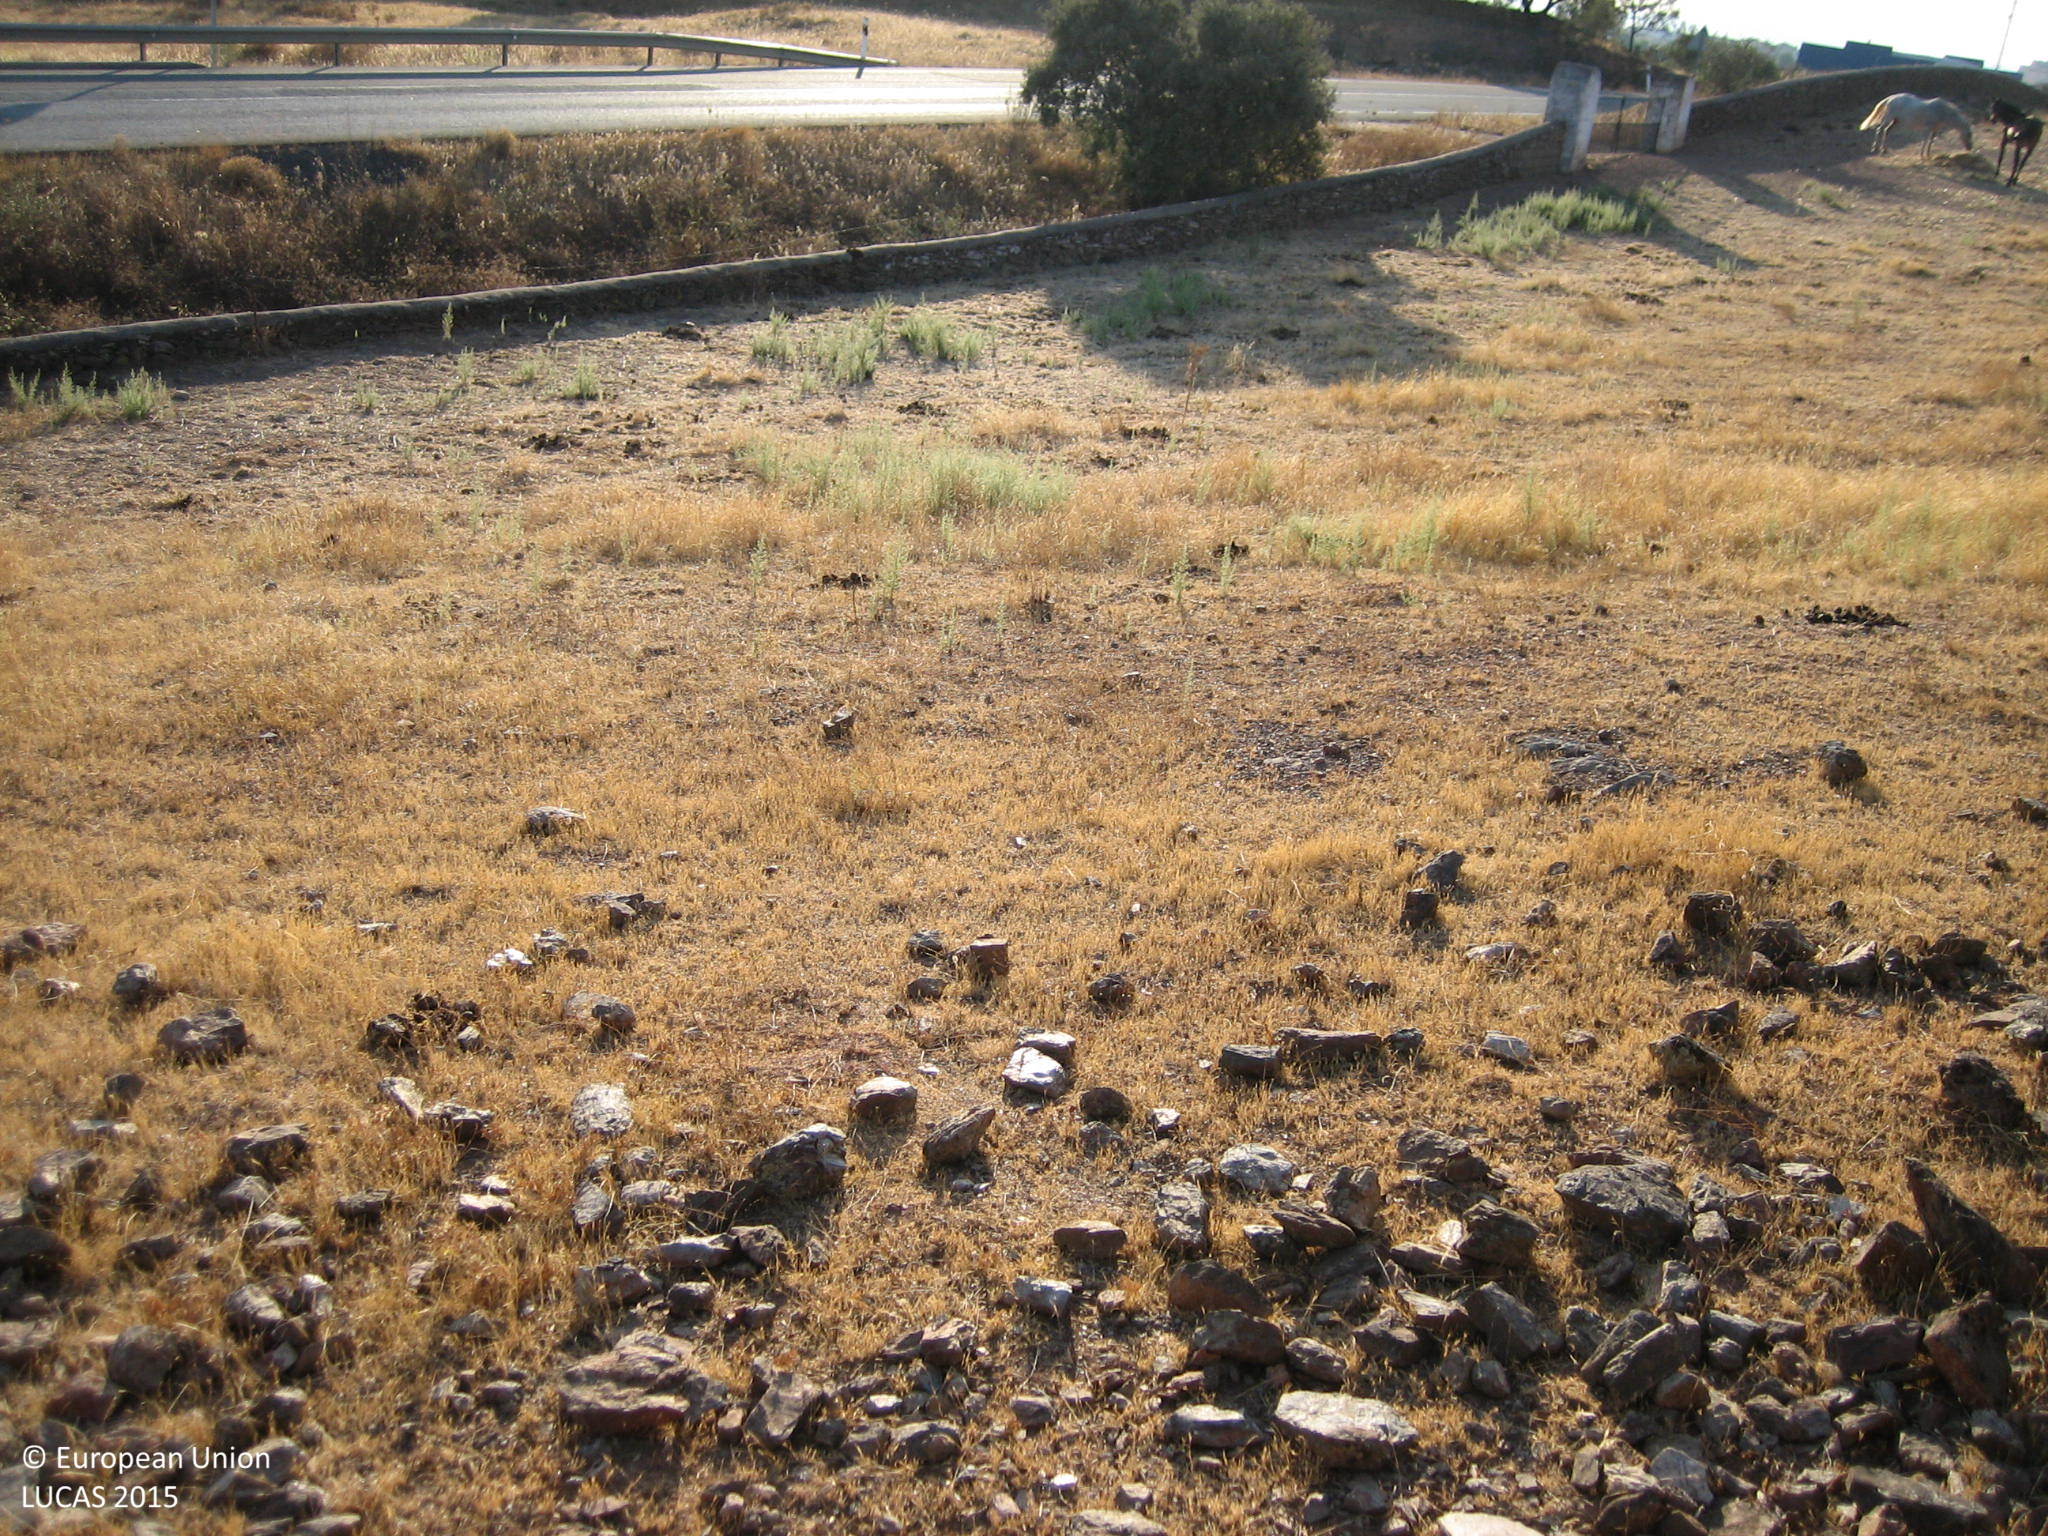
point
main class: Grassland
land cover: Grassland without tree/shrub cover
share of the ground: 50 - 75 %
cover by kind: herbaceous plants 70 %, unconsolidated bare surface 30 %
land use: Agriculture (excluding fallow land and kitchen gardens)
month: September
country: ES
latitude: 38.3746
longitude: -7.1540
